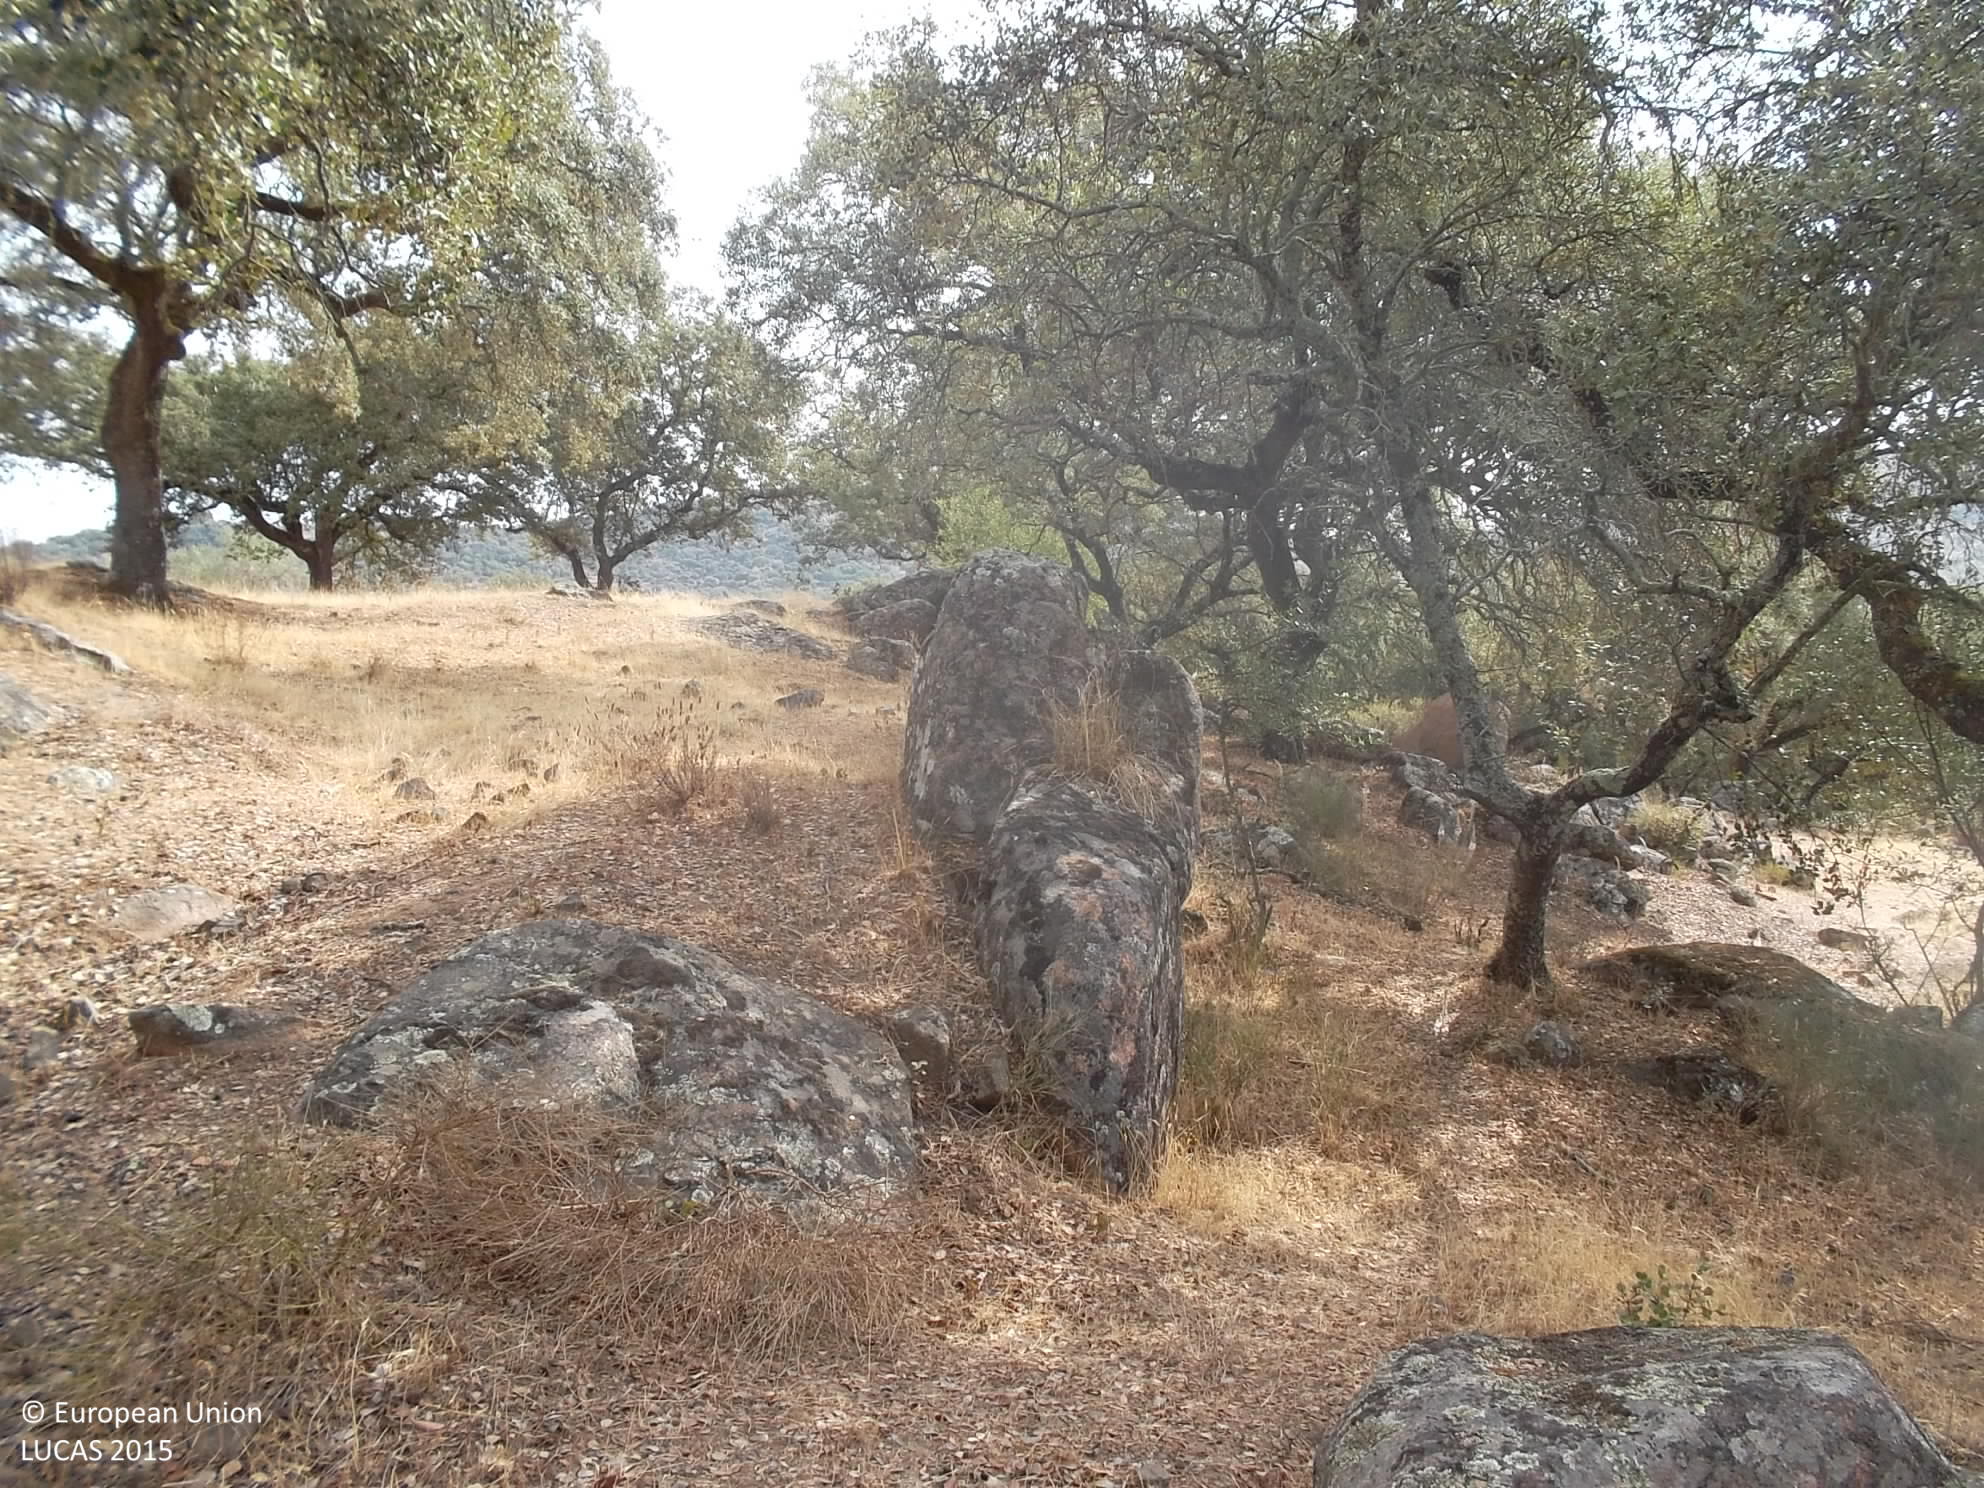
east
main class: Woodland
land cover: Broadleaved woodland
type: broadleaved evergreen forest
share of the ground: 25 - 50 %
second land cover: Grassland without tree/shrub cover
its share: 25 - 50 %
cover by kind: broadleaved forest trees 40 %, herbaceous plants 40 %, consolidated bare surface 20 %
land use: Forestry
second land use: Agriculture (excluding fallow land and kitchen gardens)
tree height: > 5 m
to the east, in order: Broadleaved woodland; Grassland without tree/shrub cover; Grassland with sparse tree/shrub cover; Rivers and streams; Groves; Dry stone walls; Grass margins; Tracks; Grass margins; Fences; Olive groves; Other fruit trees and berries
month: September
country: ES
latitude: 38.5053
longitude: -6.8367
